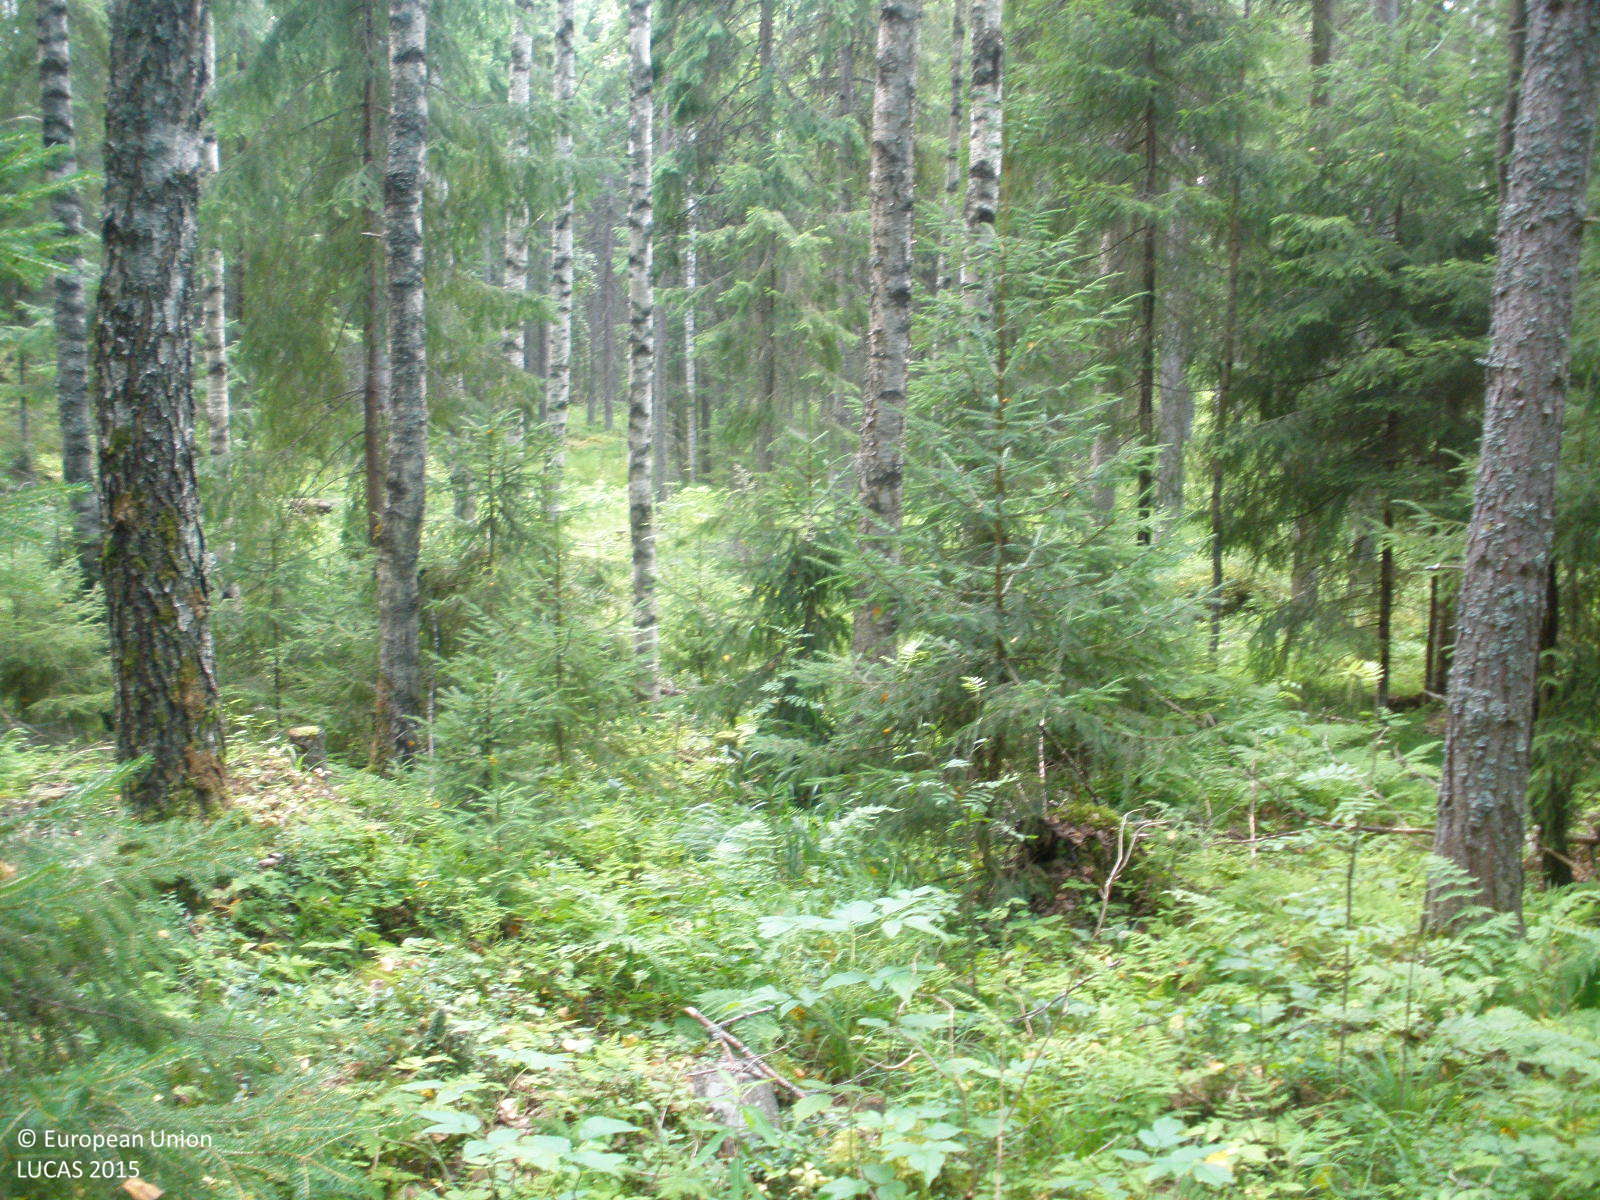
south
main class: Woodland
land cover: Spruce dominated mixed woodland
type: boreal forest
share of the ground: > 75 %
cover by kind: broadleaved forest trees 55 %, coniferous forest trees 30 %, herbaceous plants 10 %, lichens and mosses 5 %
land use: Forestry
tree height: > 5 m
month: August
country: FI
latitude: 61.0027
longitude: 24.6973
